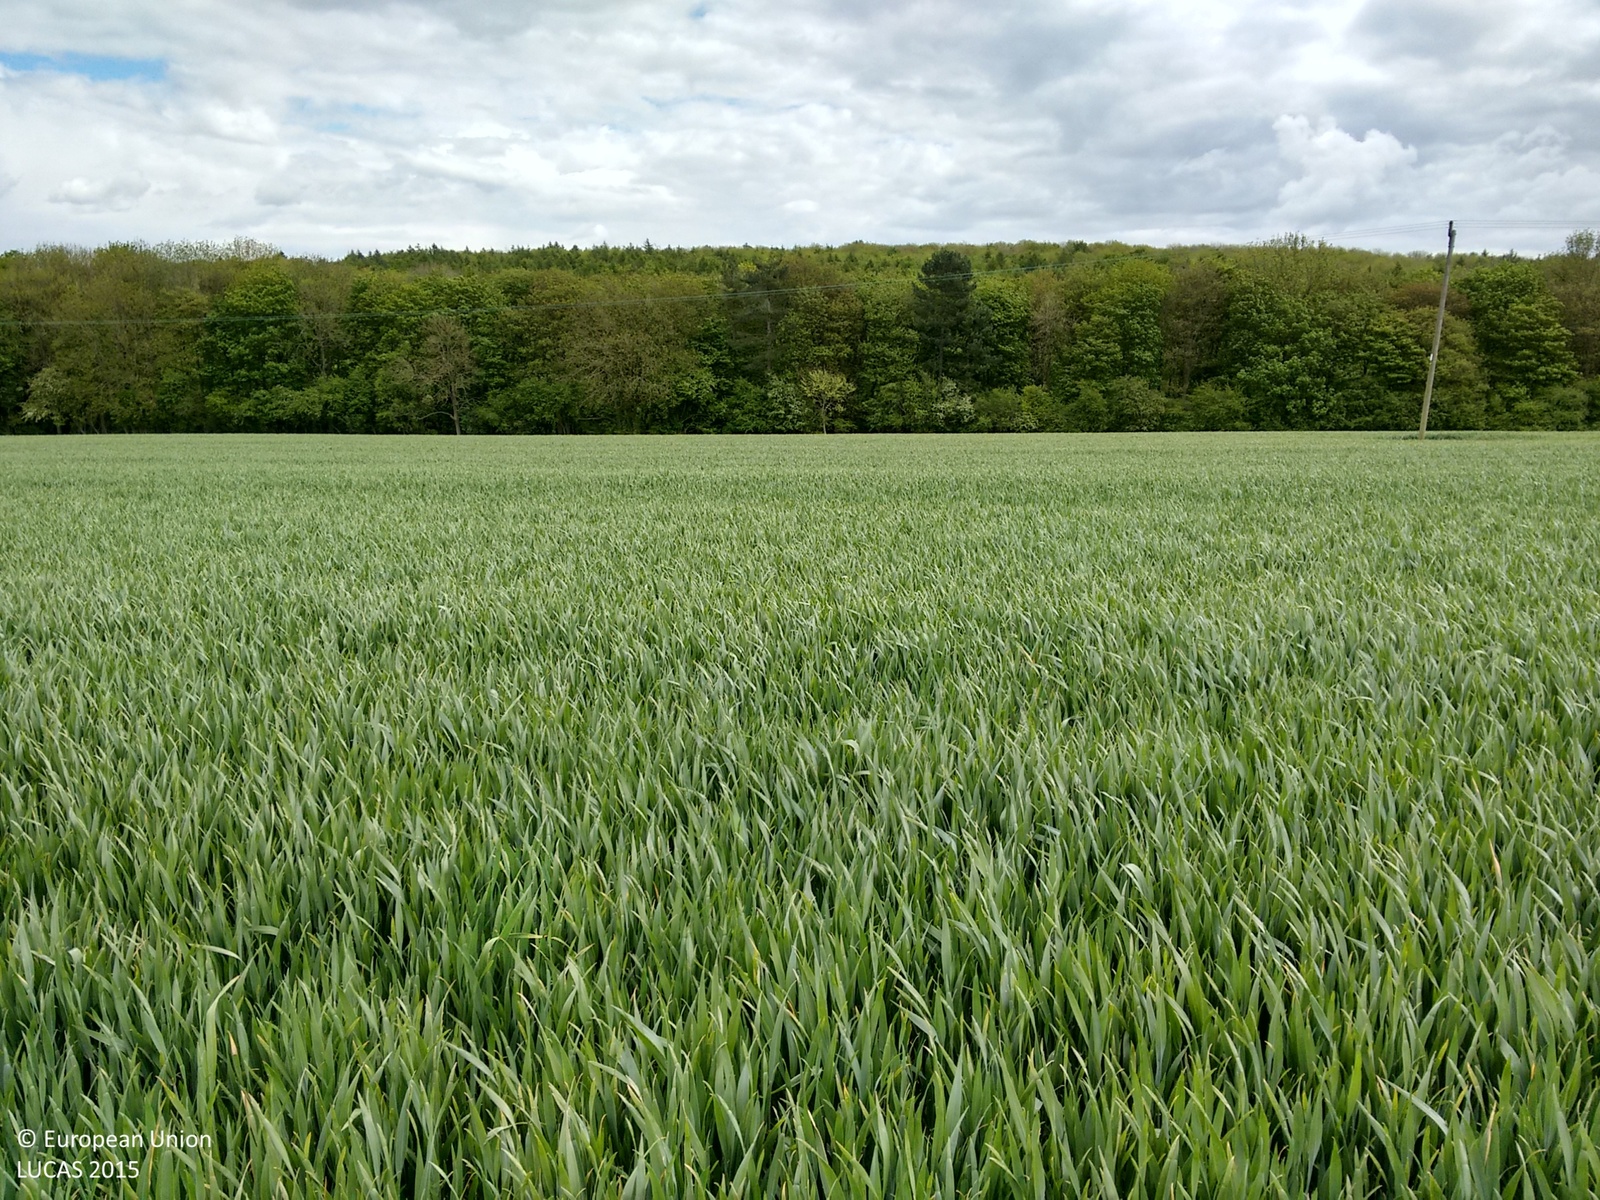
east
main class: Cropland
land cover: Common wheat
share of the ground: > 75 %
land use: Agriculture (excluding fallow land and kitchen gardens)
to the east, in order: Common wheat; Electric lines; Common wheat; Grassland without tree/shrub cover; Fences; Broadleaved woodland; Tracks; Broadleaved woodland; Grassland without tree/shrub cover
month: May
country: GB
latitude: 53.4773
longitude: -0.2044
